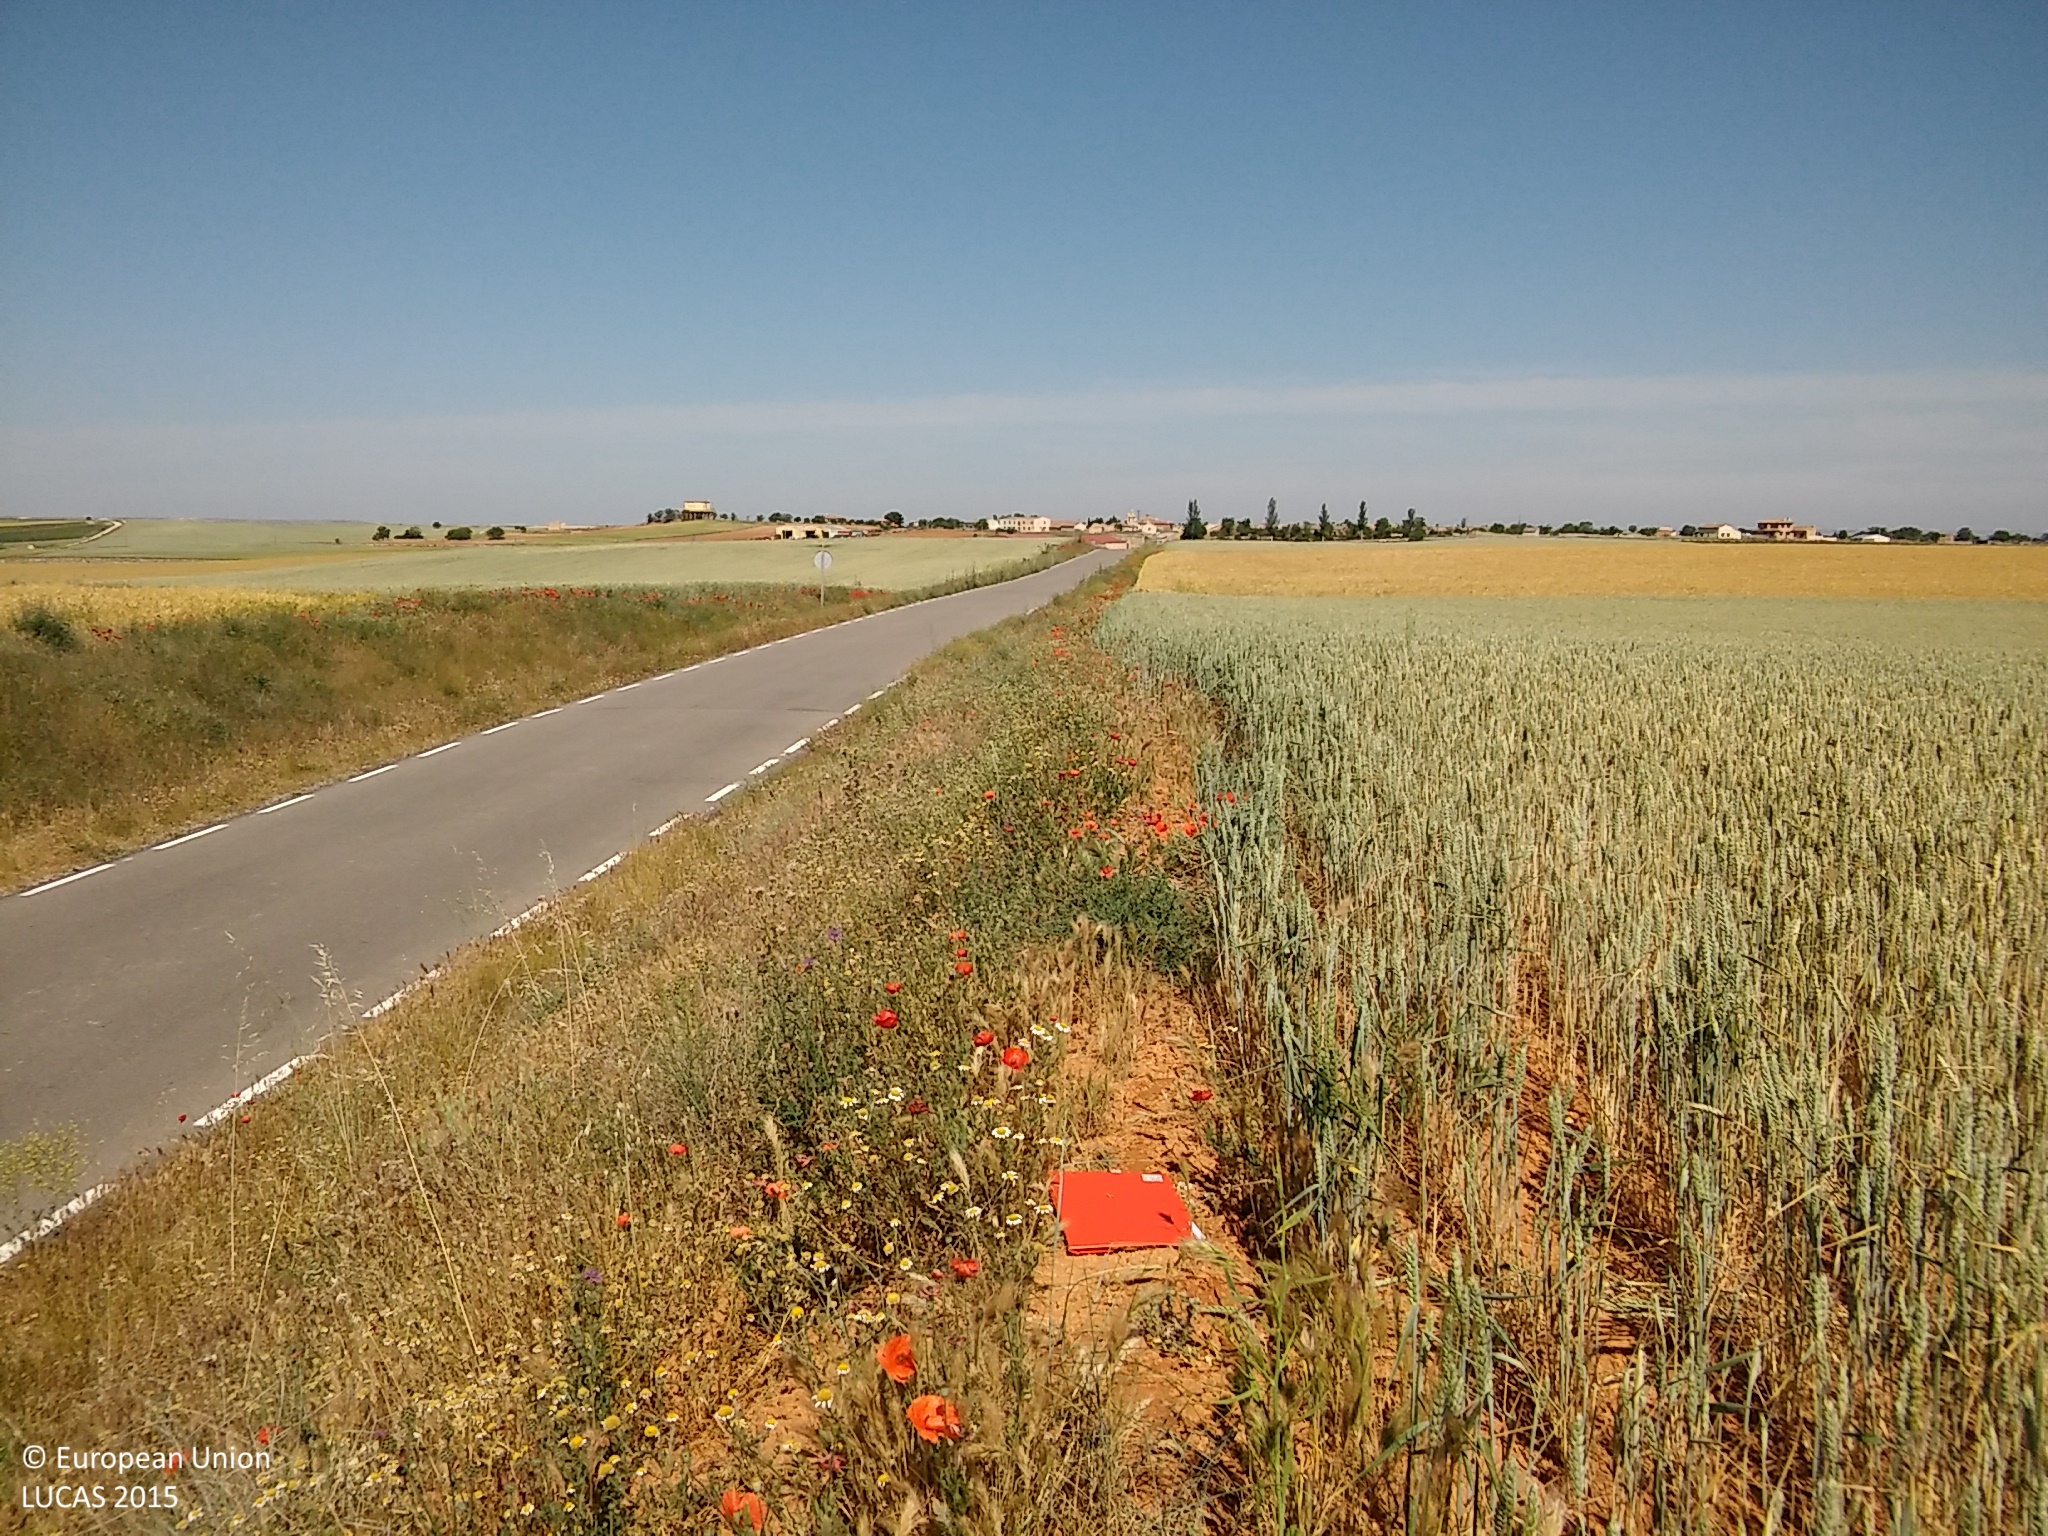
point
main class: Cropland
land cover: Common wheat
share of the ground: 50 - 75 %
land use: Agriculture (excluding fallow land and kitchen gardens)
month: June
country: ES
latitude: 41.6057
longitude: -3.7193
